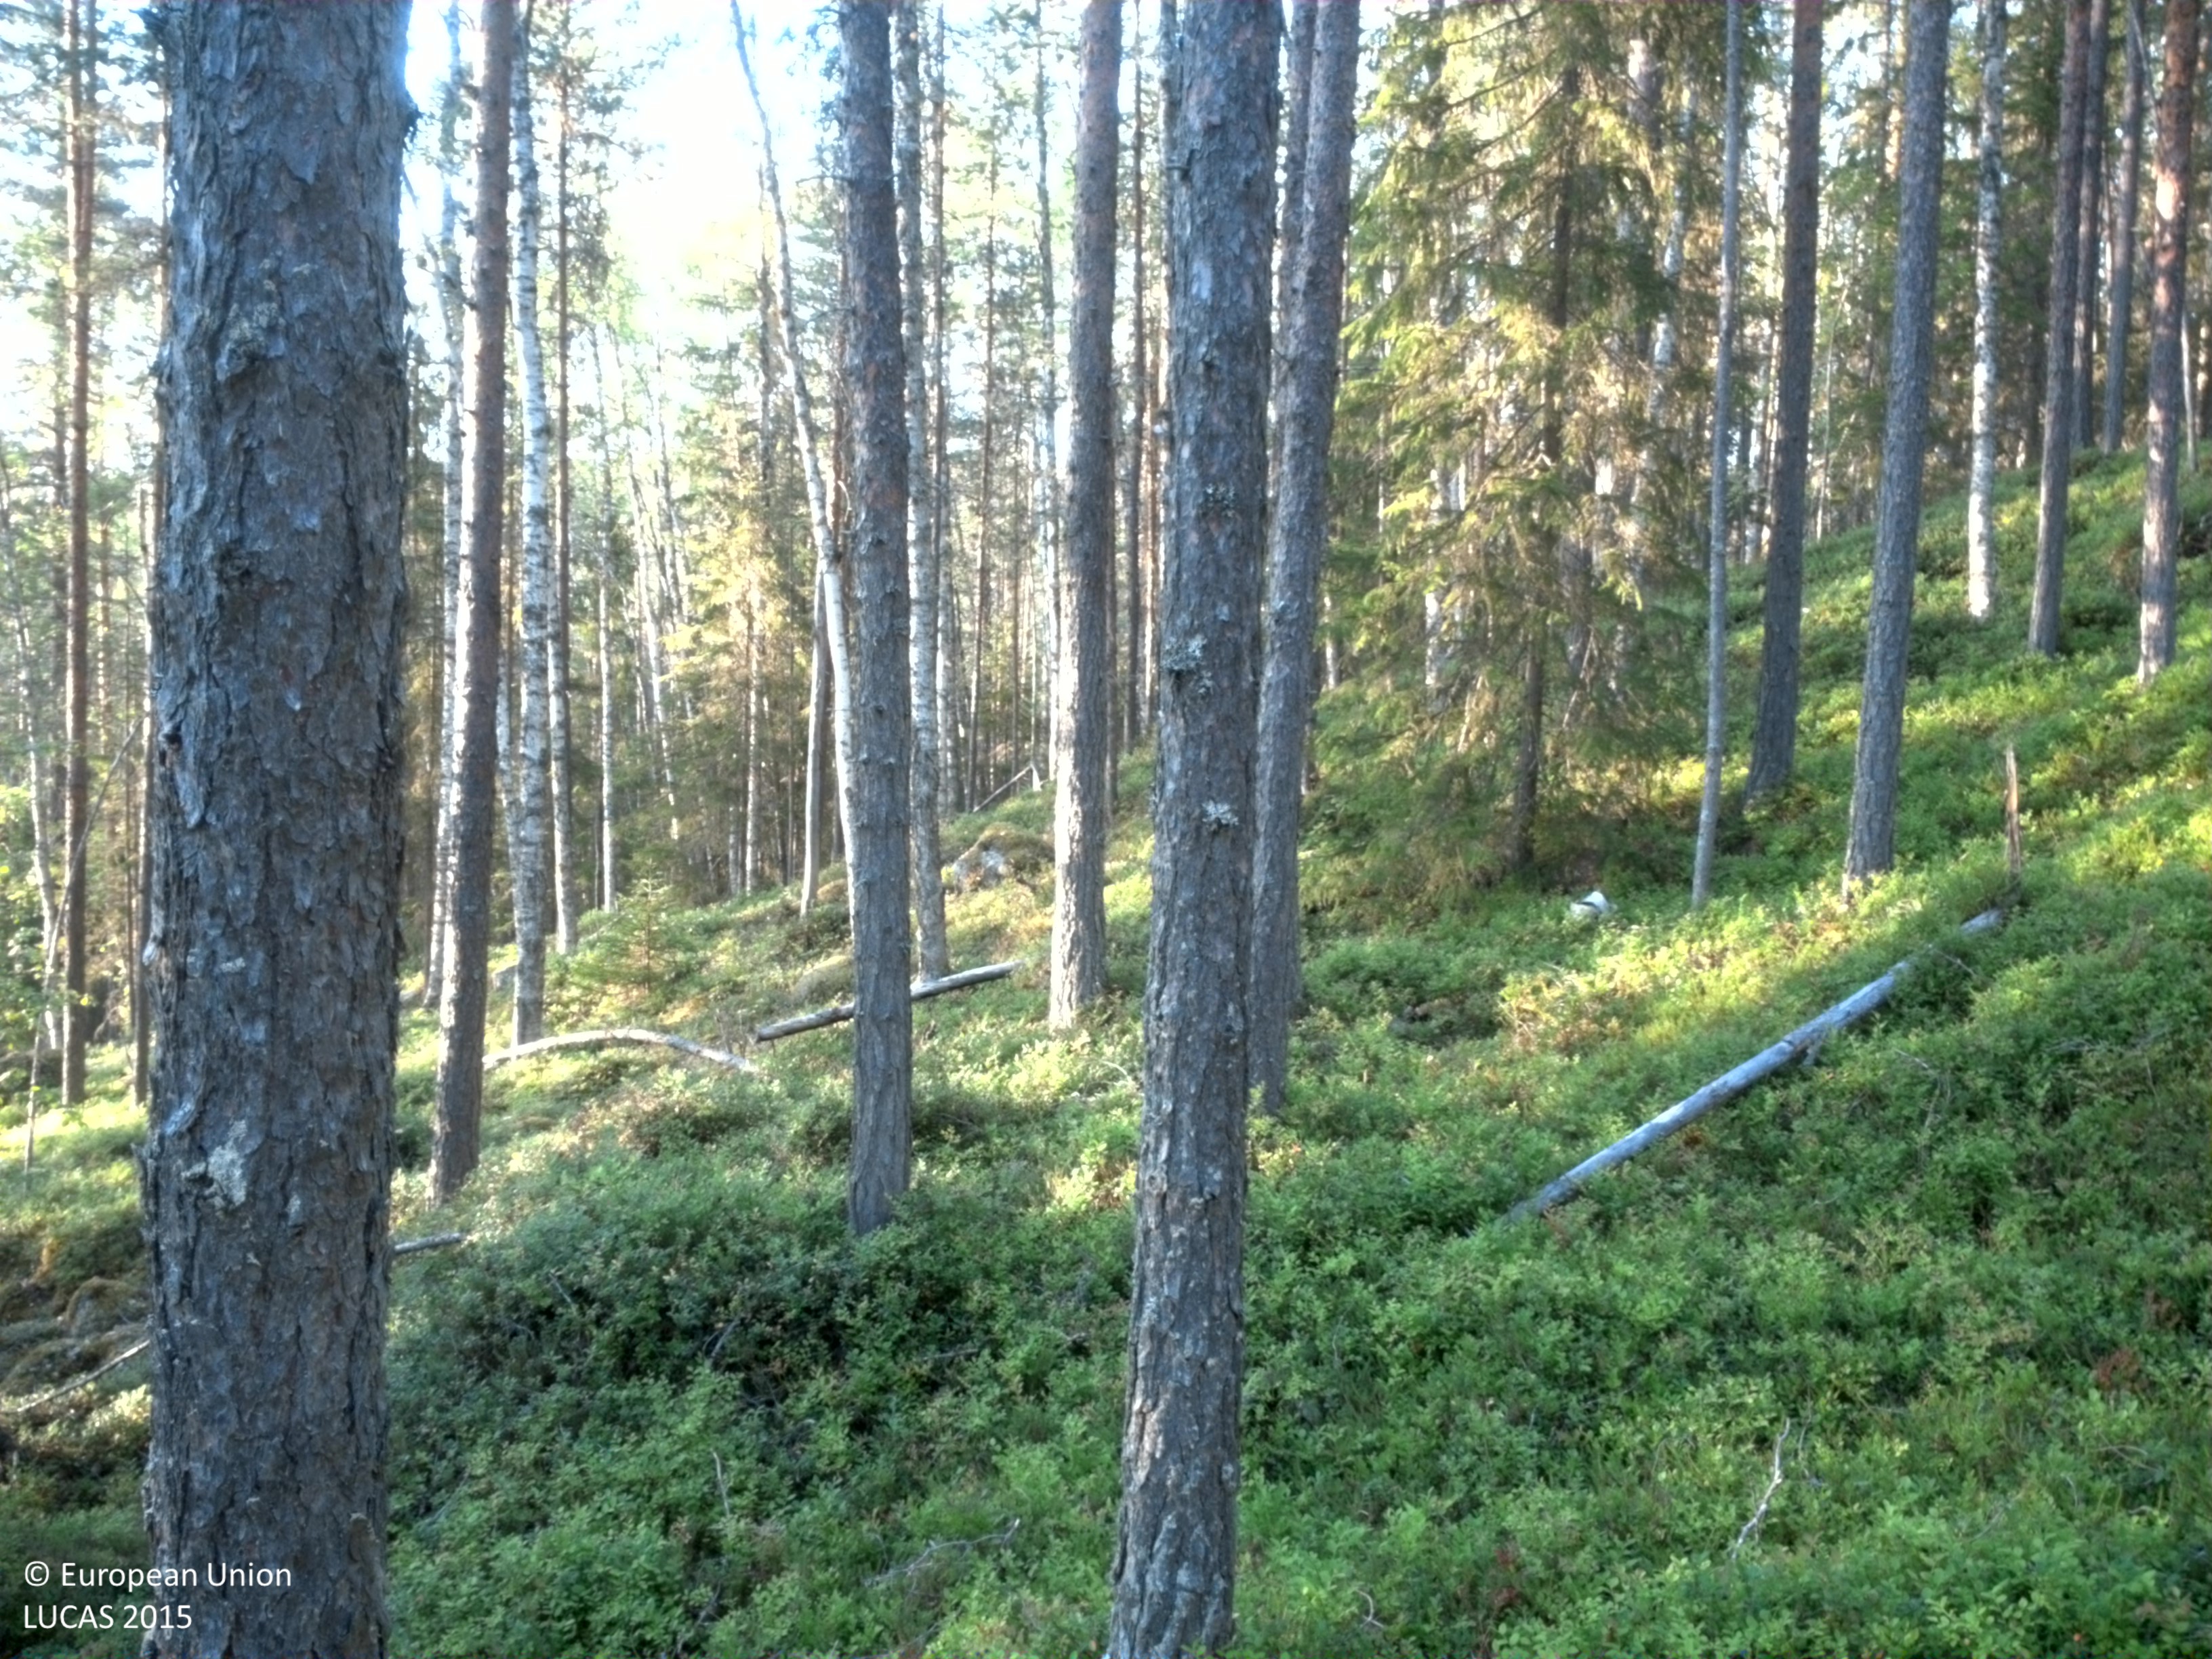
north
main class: Woodland
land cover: Pine dominated coniferous woodland
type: boreal forest
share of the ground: 25 - 50 %
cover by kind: coniferous forest trees 50 %, shrubs 50 %
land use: Forestry
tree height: > 5 m
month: August
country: SE
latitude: 64.4666
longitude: 19.0568
